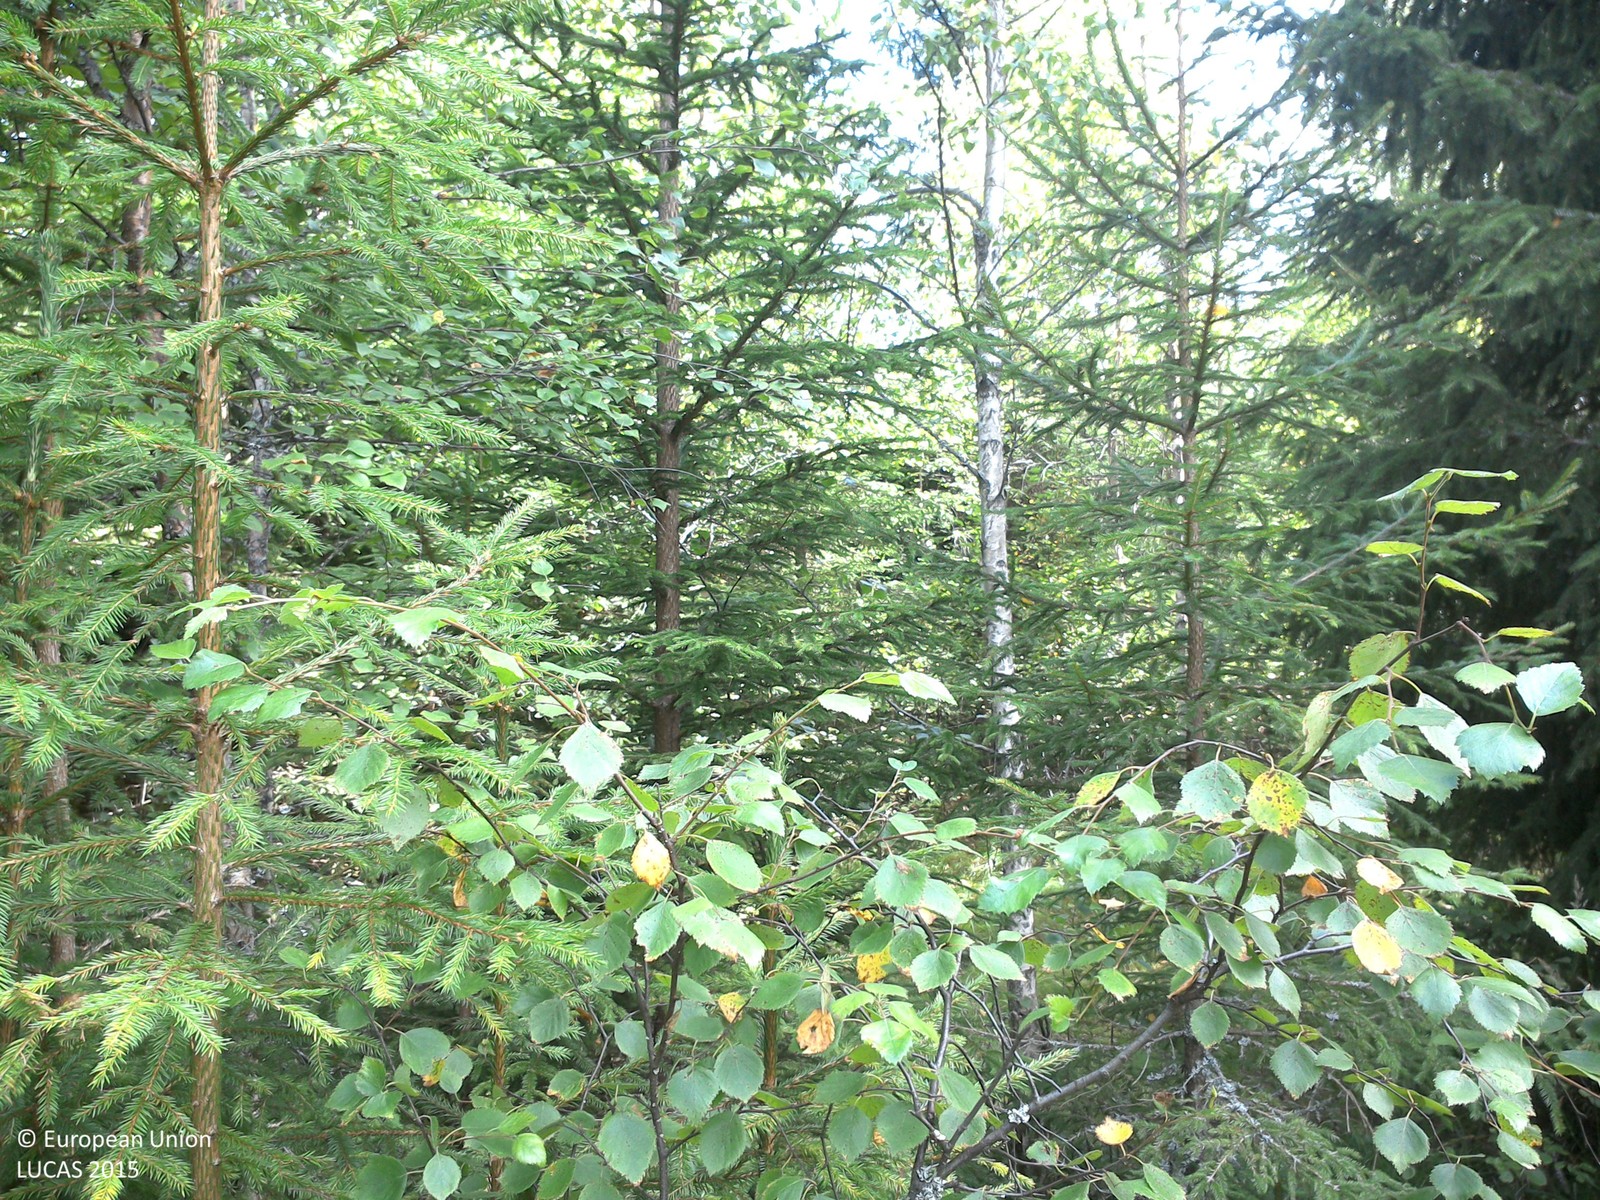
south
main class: Woodland
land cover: Spruce dominated coniferous woodland
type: boreal forest
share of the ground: > 75 %
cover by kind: coniferous forest trees 75 %, broadleaved forest trees 15 %, herbaceous plants 10 %
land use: Forestry
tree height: < 5 m
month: August
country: SE
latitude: 57.7589
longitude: 15.1889
